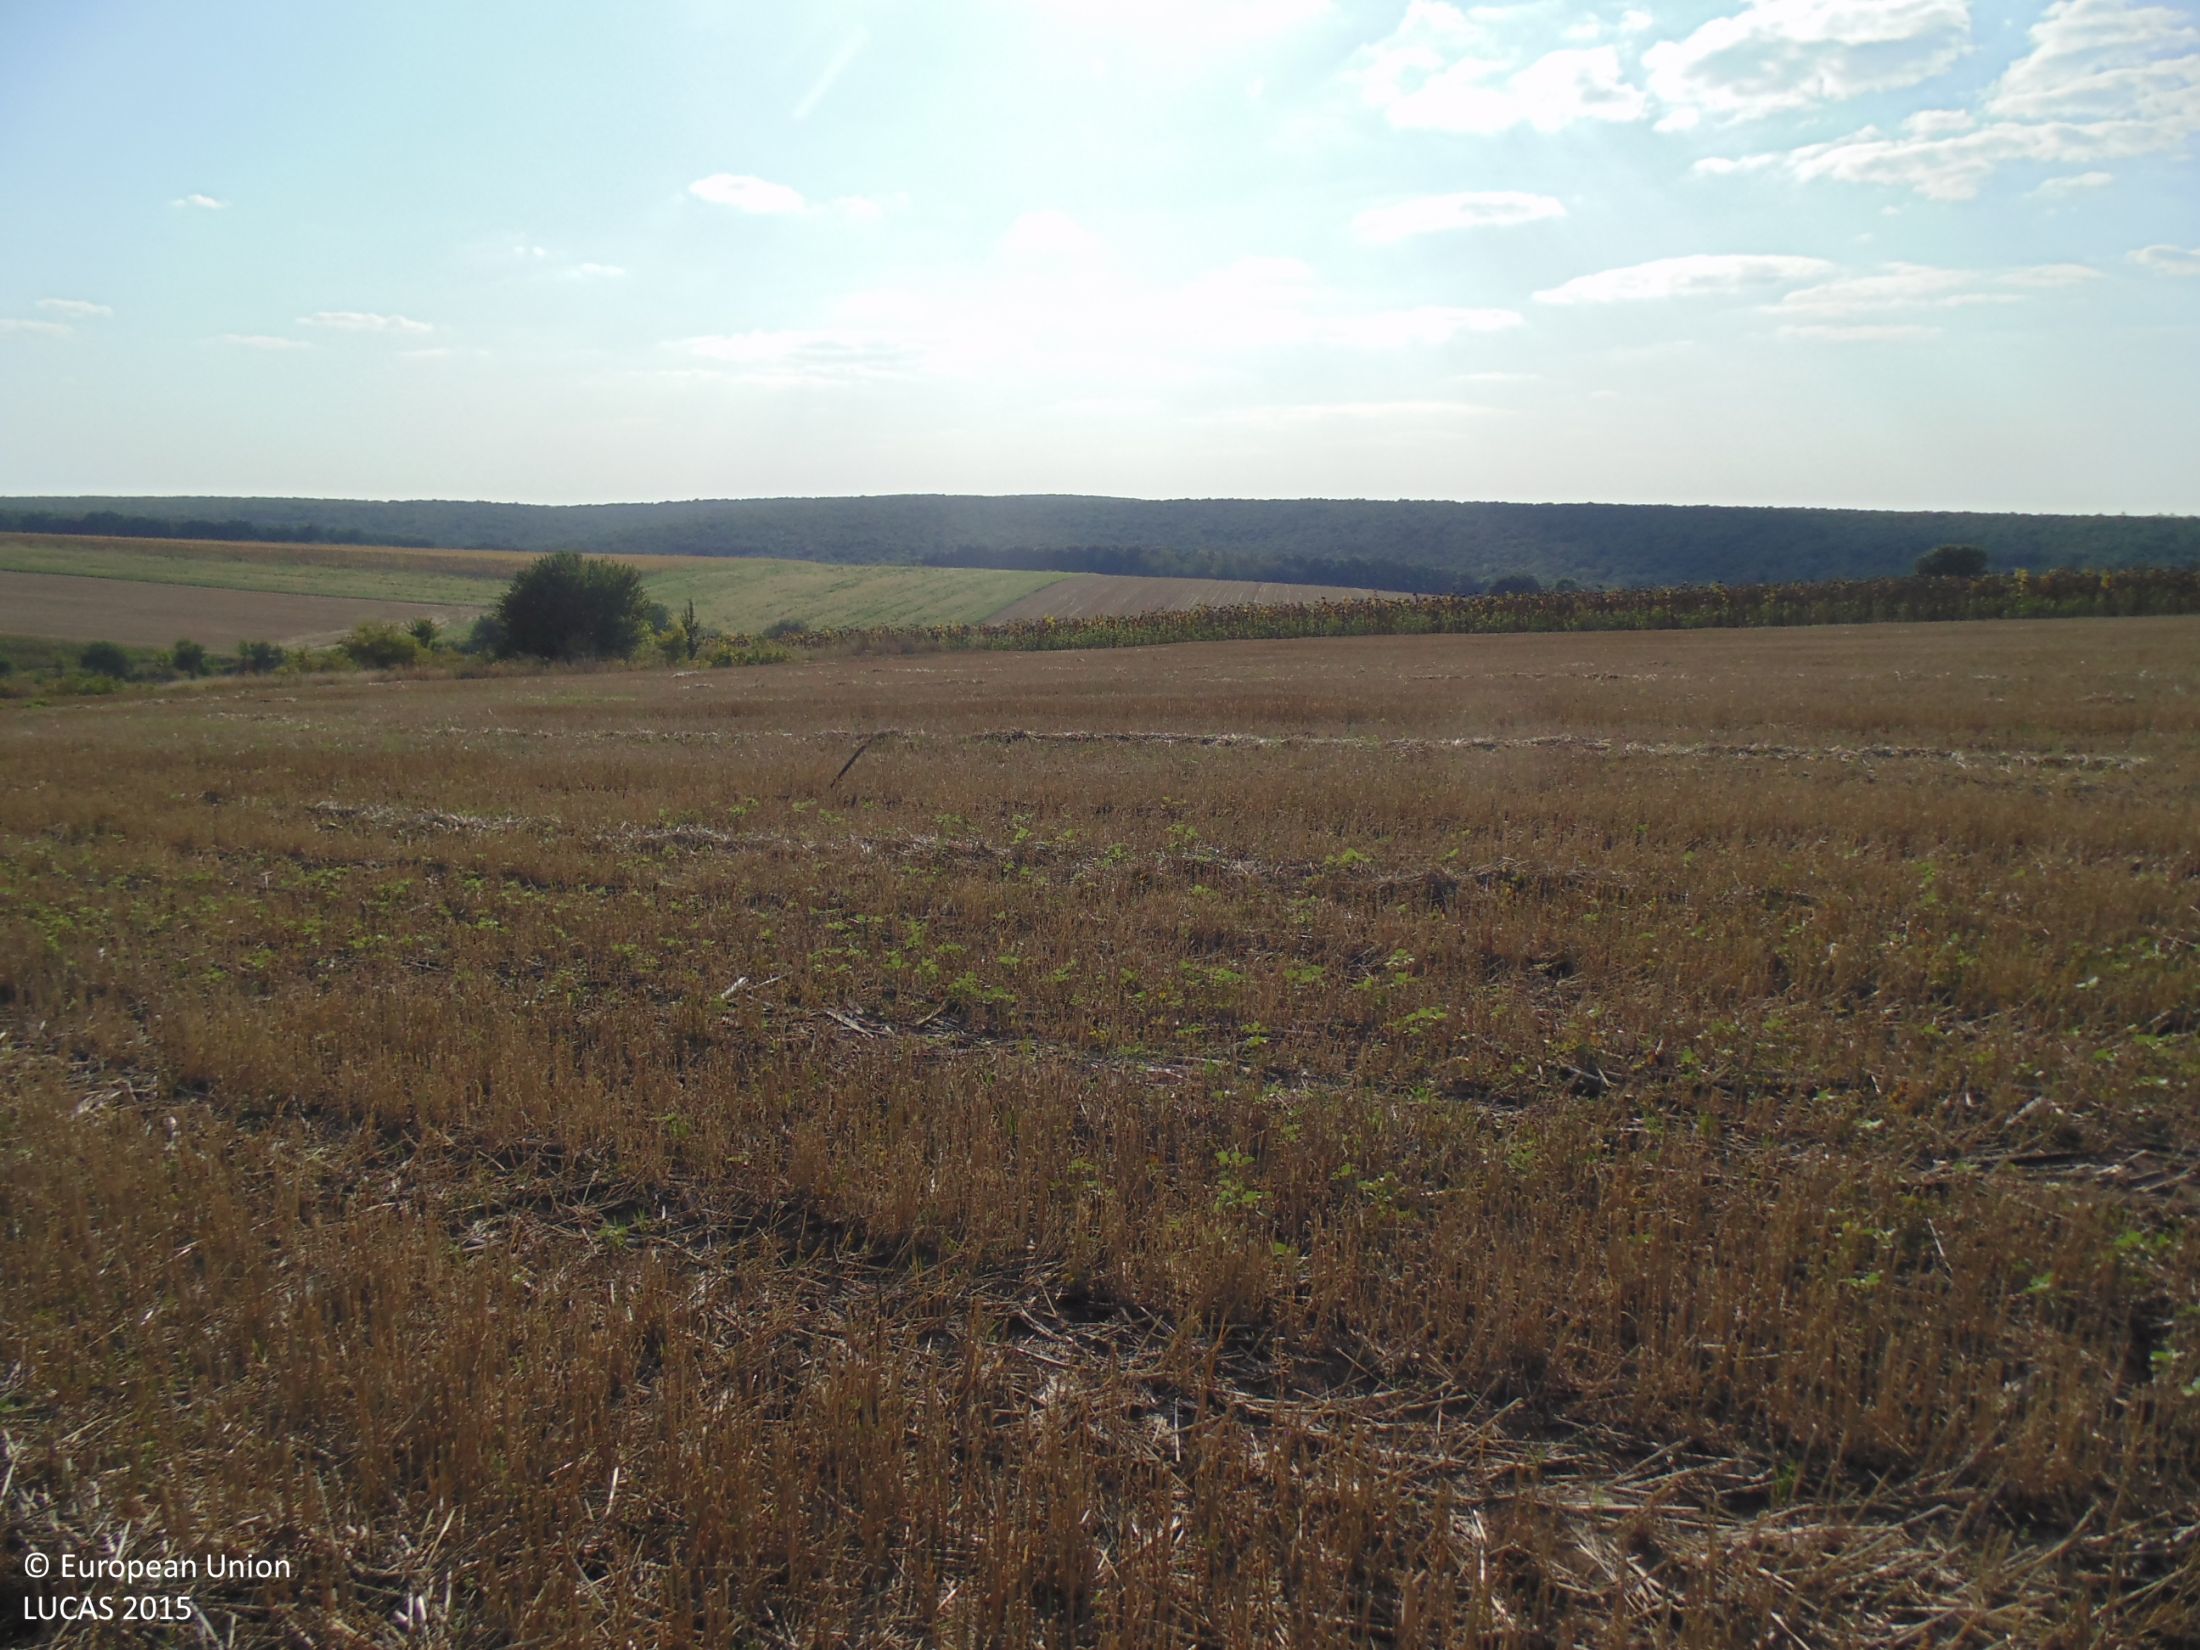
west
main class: Cropland
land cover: Common wheat
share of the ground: 50 - 75 %
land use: Agriculture (excluding fallow land and kitchen gardens)
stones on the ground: < 10 %
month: August
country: BG
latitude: 43.7396
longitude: 27.2496
